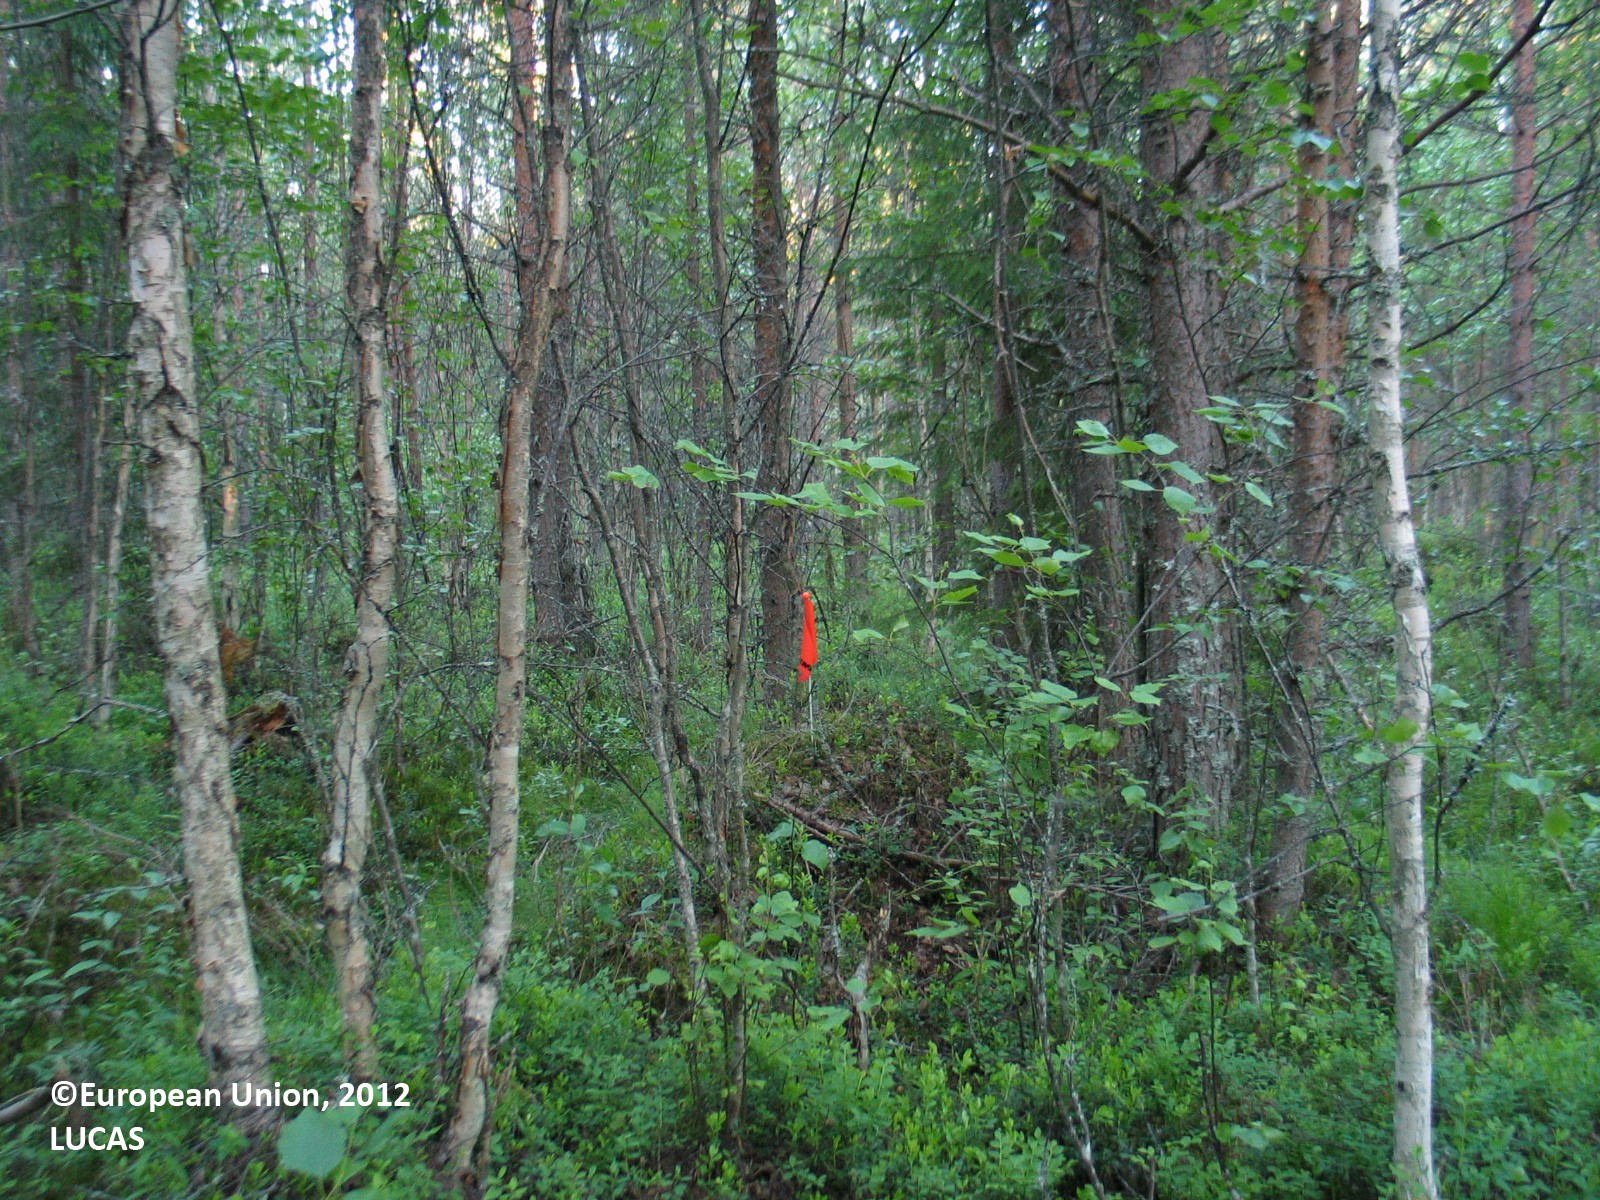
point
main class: Woodland
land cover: Pine dominated mixed woodland
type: boreal forest
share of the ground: > 75 %
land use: Forestry
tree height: > 5 m
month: July
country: FI
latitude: 64.7912
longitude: 26.6328
